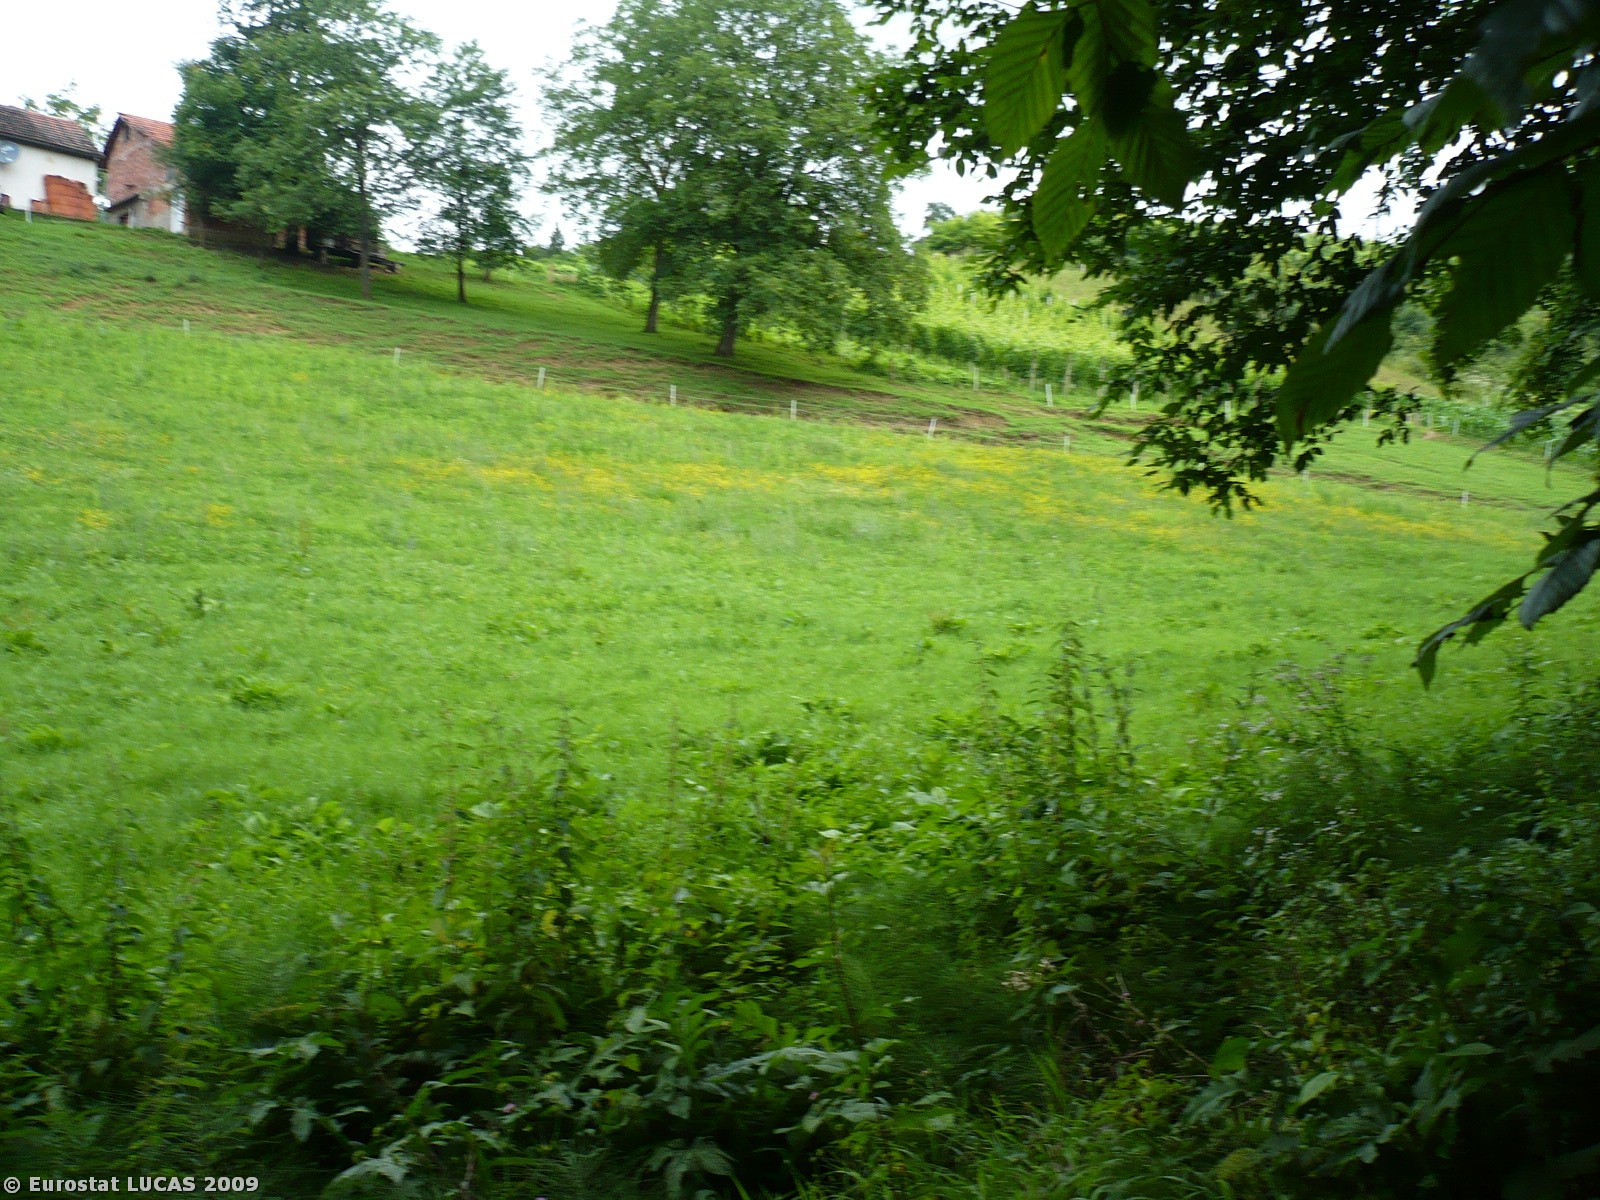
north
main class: Woodland
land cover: Broadleaved woodland
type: beech forest
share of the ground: > 75 %
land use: Agriculture (excluding fallow land and kitchen gardens)
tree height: > 5 m
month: June
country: SI
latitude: 46.3595
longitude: 16.0691
